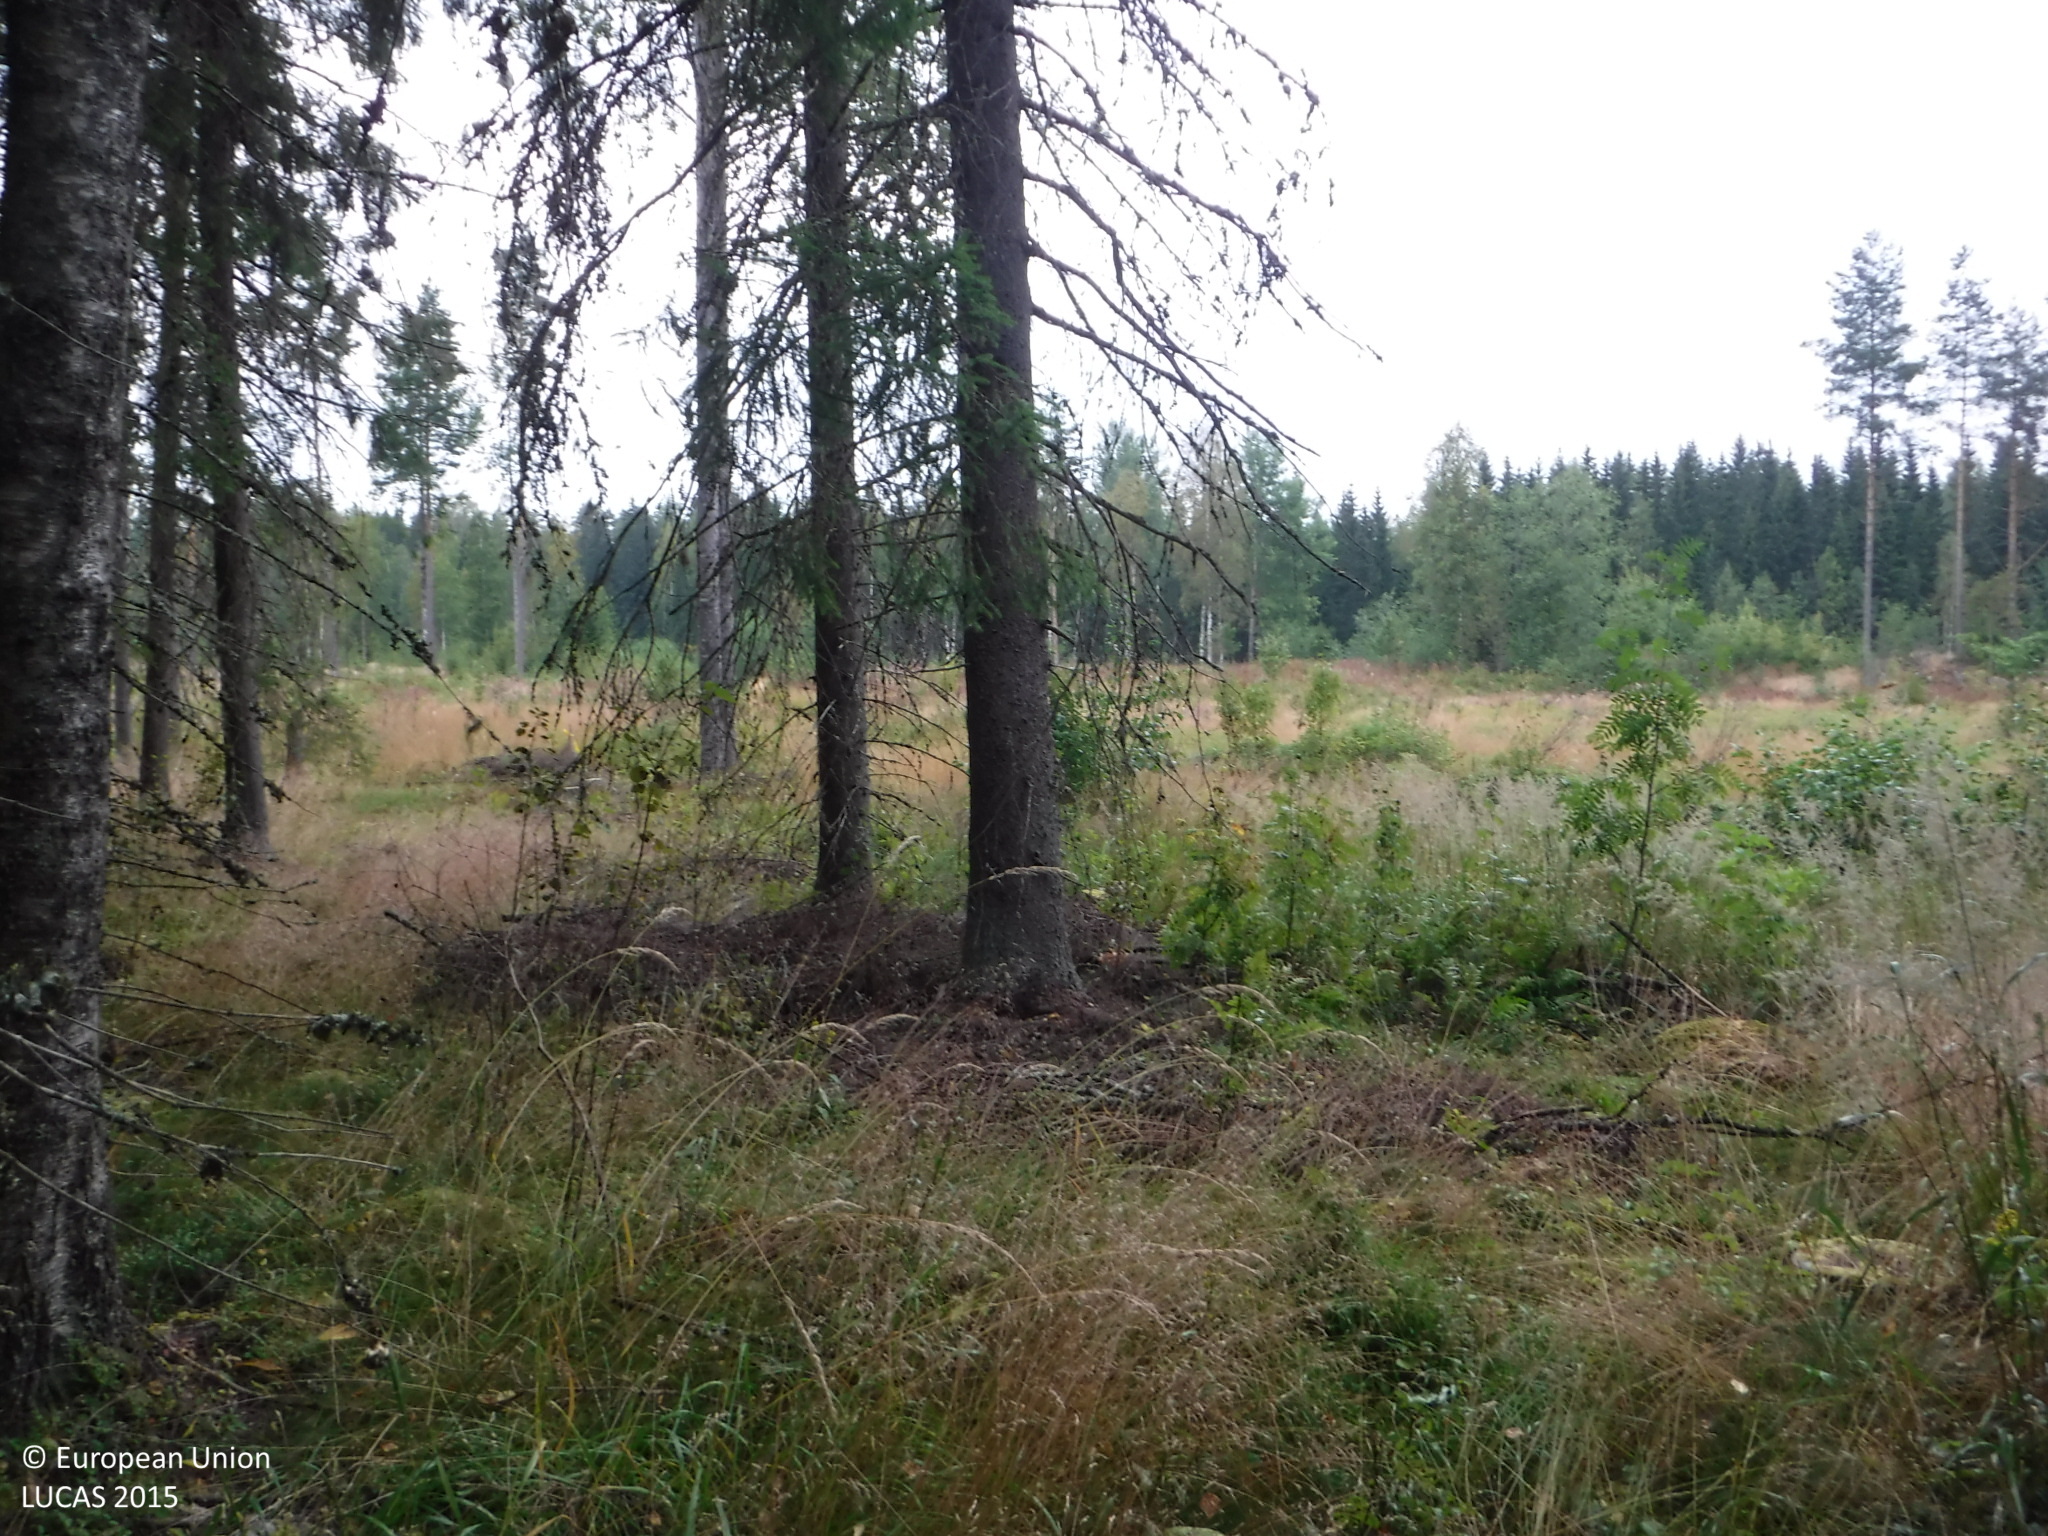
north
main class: Woodland
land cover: Spruce dominated coniferous woodland
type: boreal forest
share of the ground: > 75 %
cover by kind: coniferous forest trees 75 %, lichens and mosses 15 %, broadleaved forest trees 5 %, shrubs 5 %
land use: Forestry
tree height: > 5 m
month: August
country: FI
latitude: 61.2206
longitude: 23.0142
